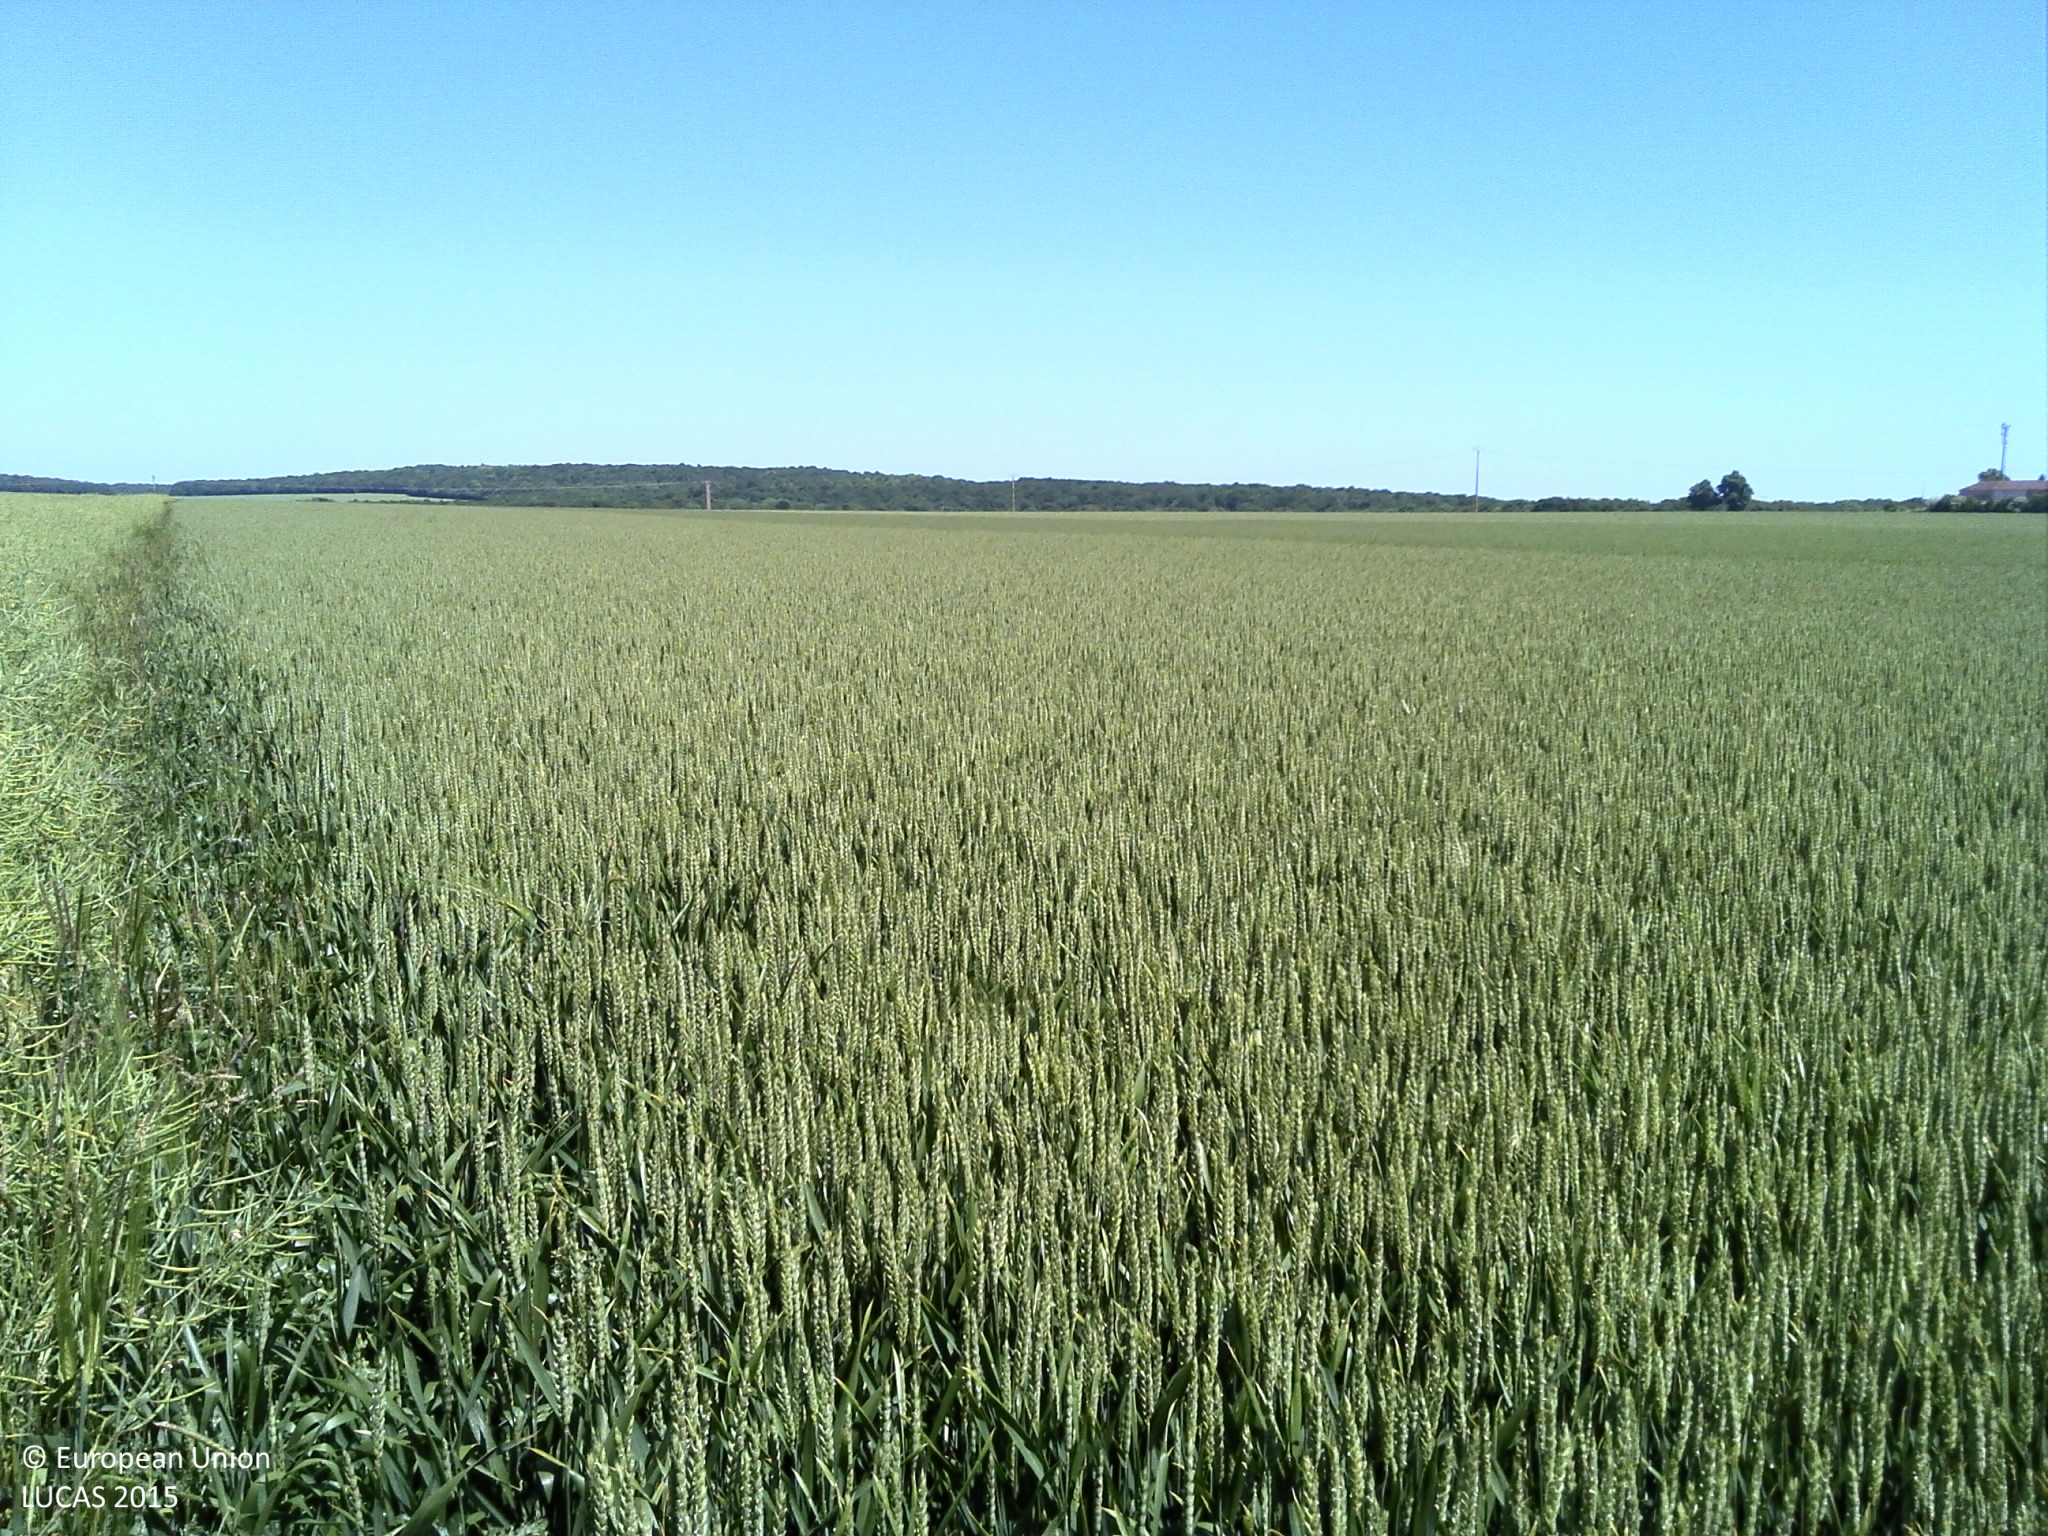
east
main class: Cropland
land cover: Rape and turnip rape
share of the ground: > 75 %
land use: Agriculture (excluding fallow land and kitchen gardens)
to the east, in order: Rape and turnip rape; Grass margins; Common wheat
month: June
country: FR
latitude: 49.1610
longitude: 6.0364
